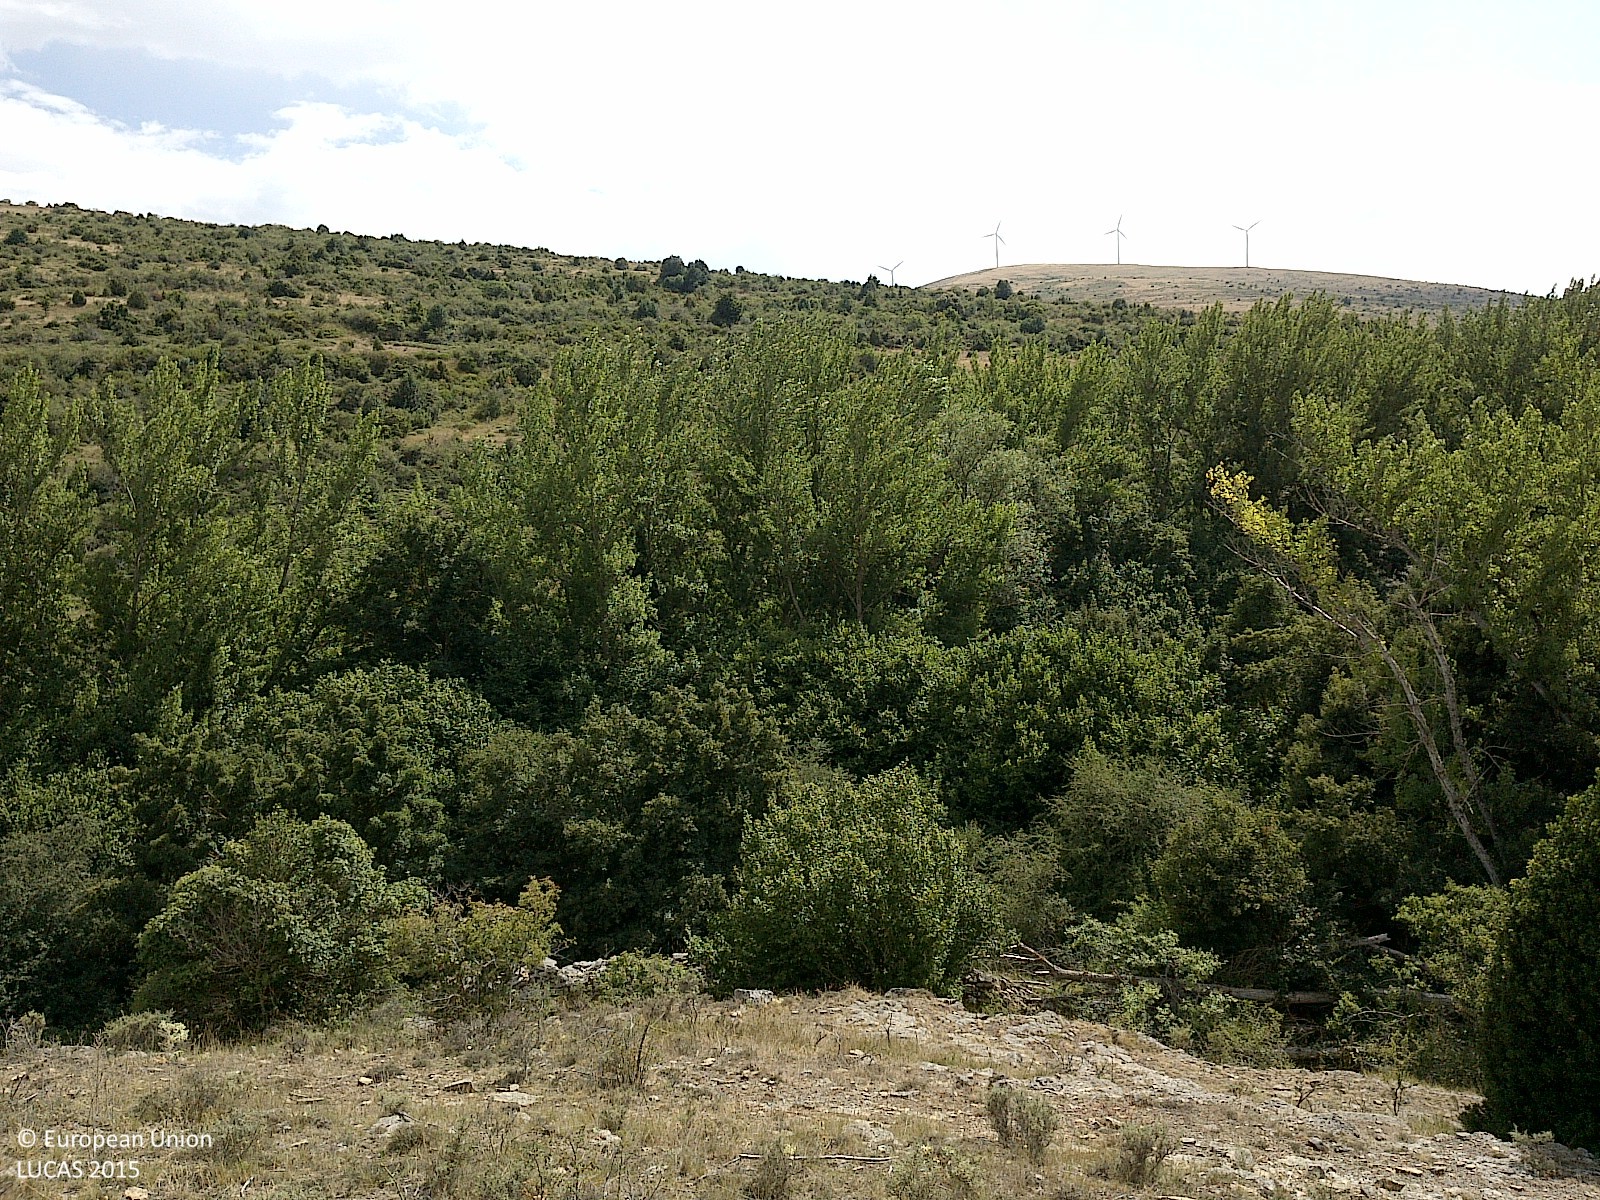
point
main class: Shrubland
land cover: Shrubland with sparse tree cover
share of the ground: 50 - 75 %
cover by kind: shrubs 60 %, herbaceous plants 35 %, broadleaved forest trees 5 %
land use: Semi-natural and natural areas not in use
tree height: < 5 m
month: July
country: ES
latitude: 41.9758
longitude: -2.2873
